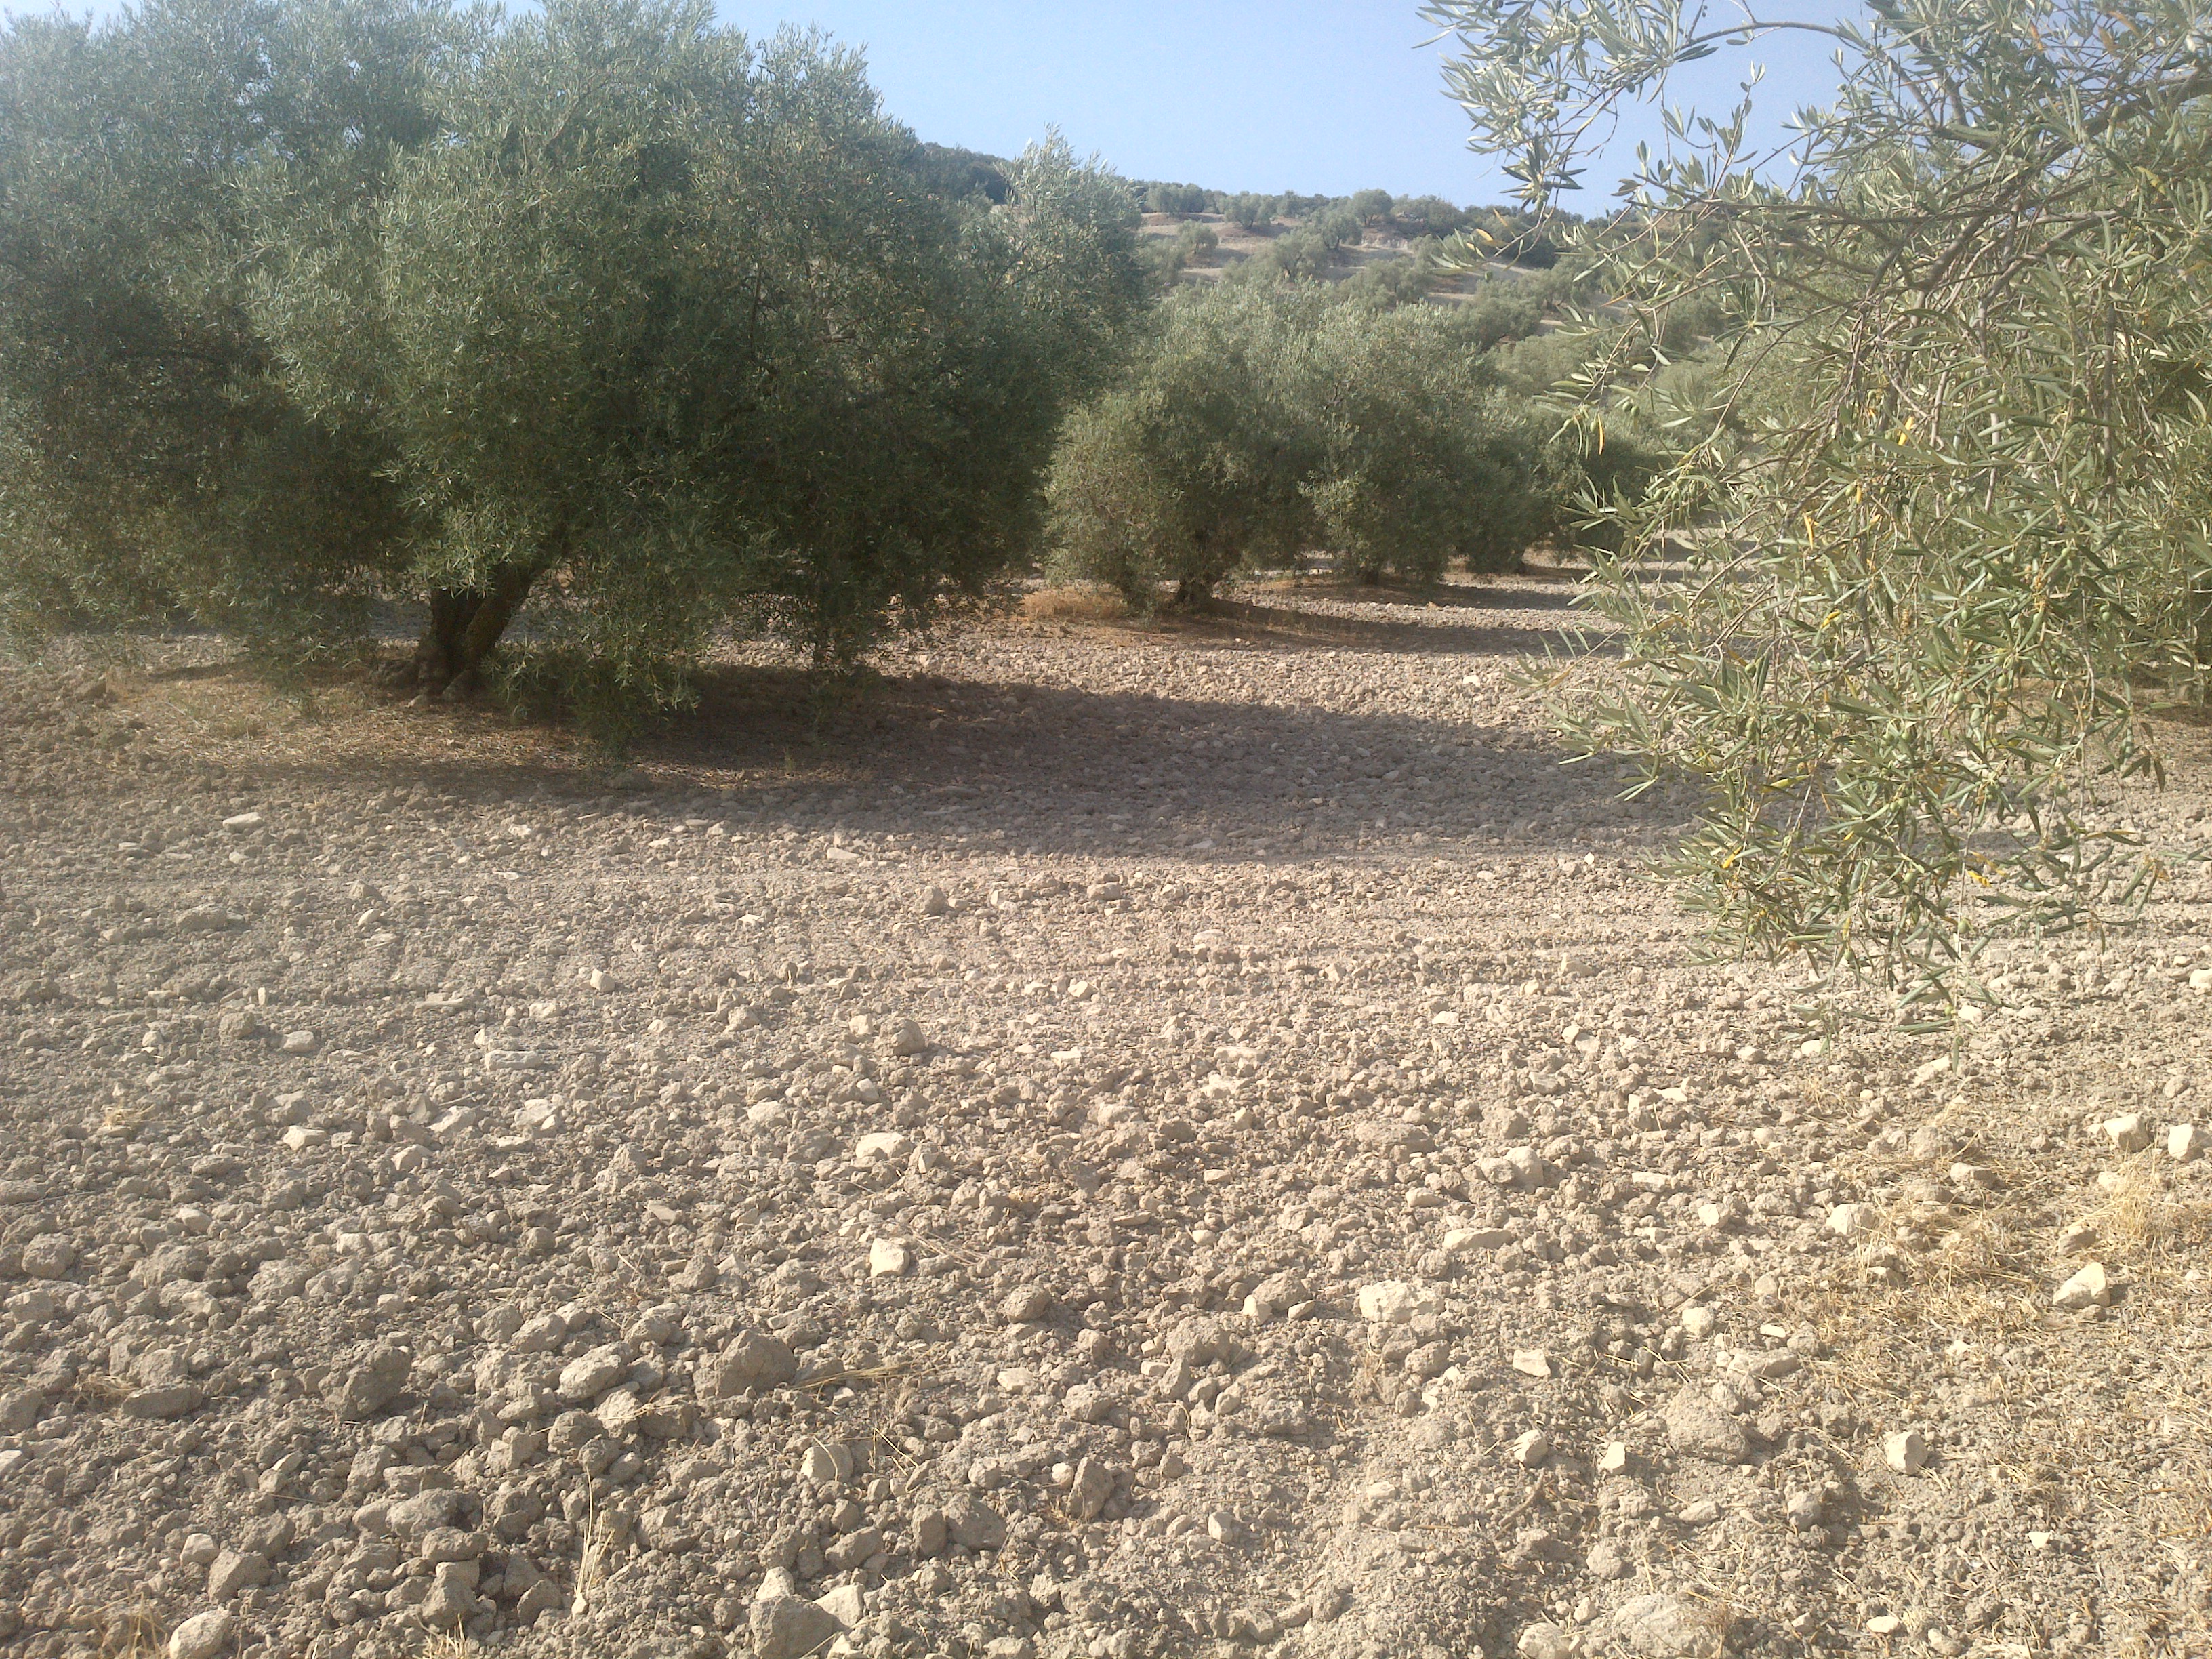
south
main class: Cropland
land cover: Olive groves
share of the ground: 50 - 75 %
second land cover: Other bare soil
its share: > 75 %
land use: Agriculture (excluding fallow land and kitchen gardens)
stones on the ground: < 10 %
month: June
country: ES
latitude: 37.6570
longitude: -4.2754
